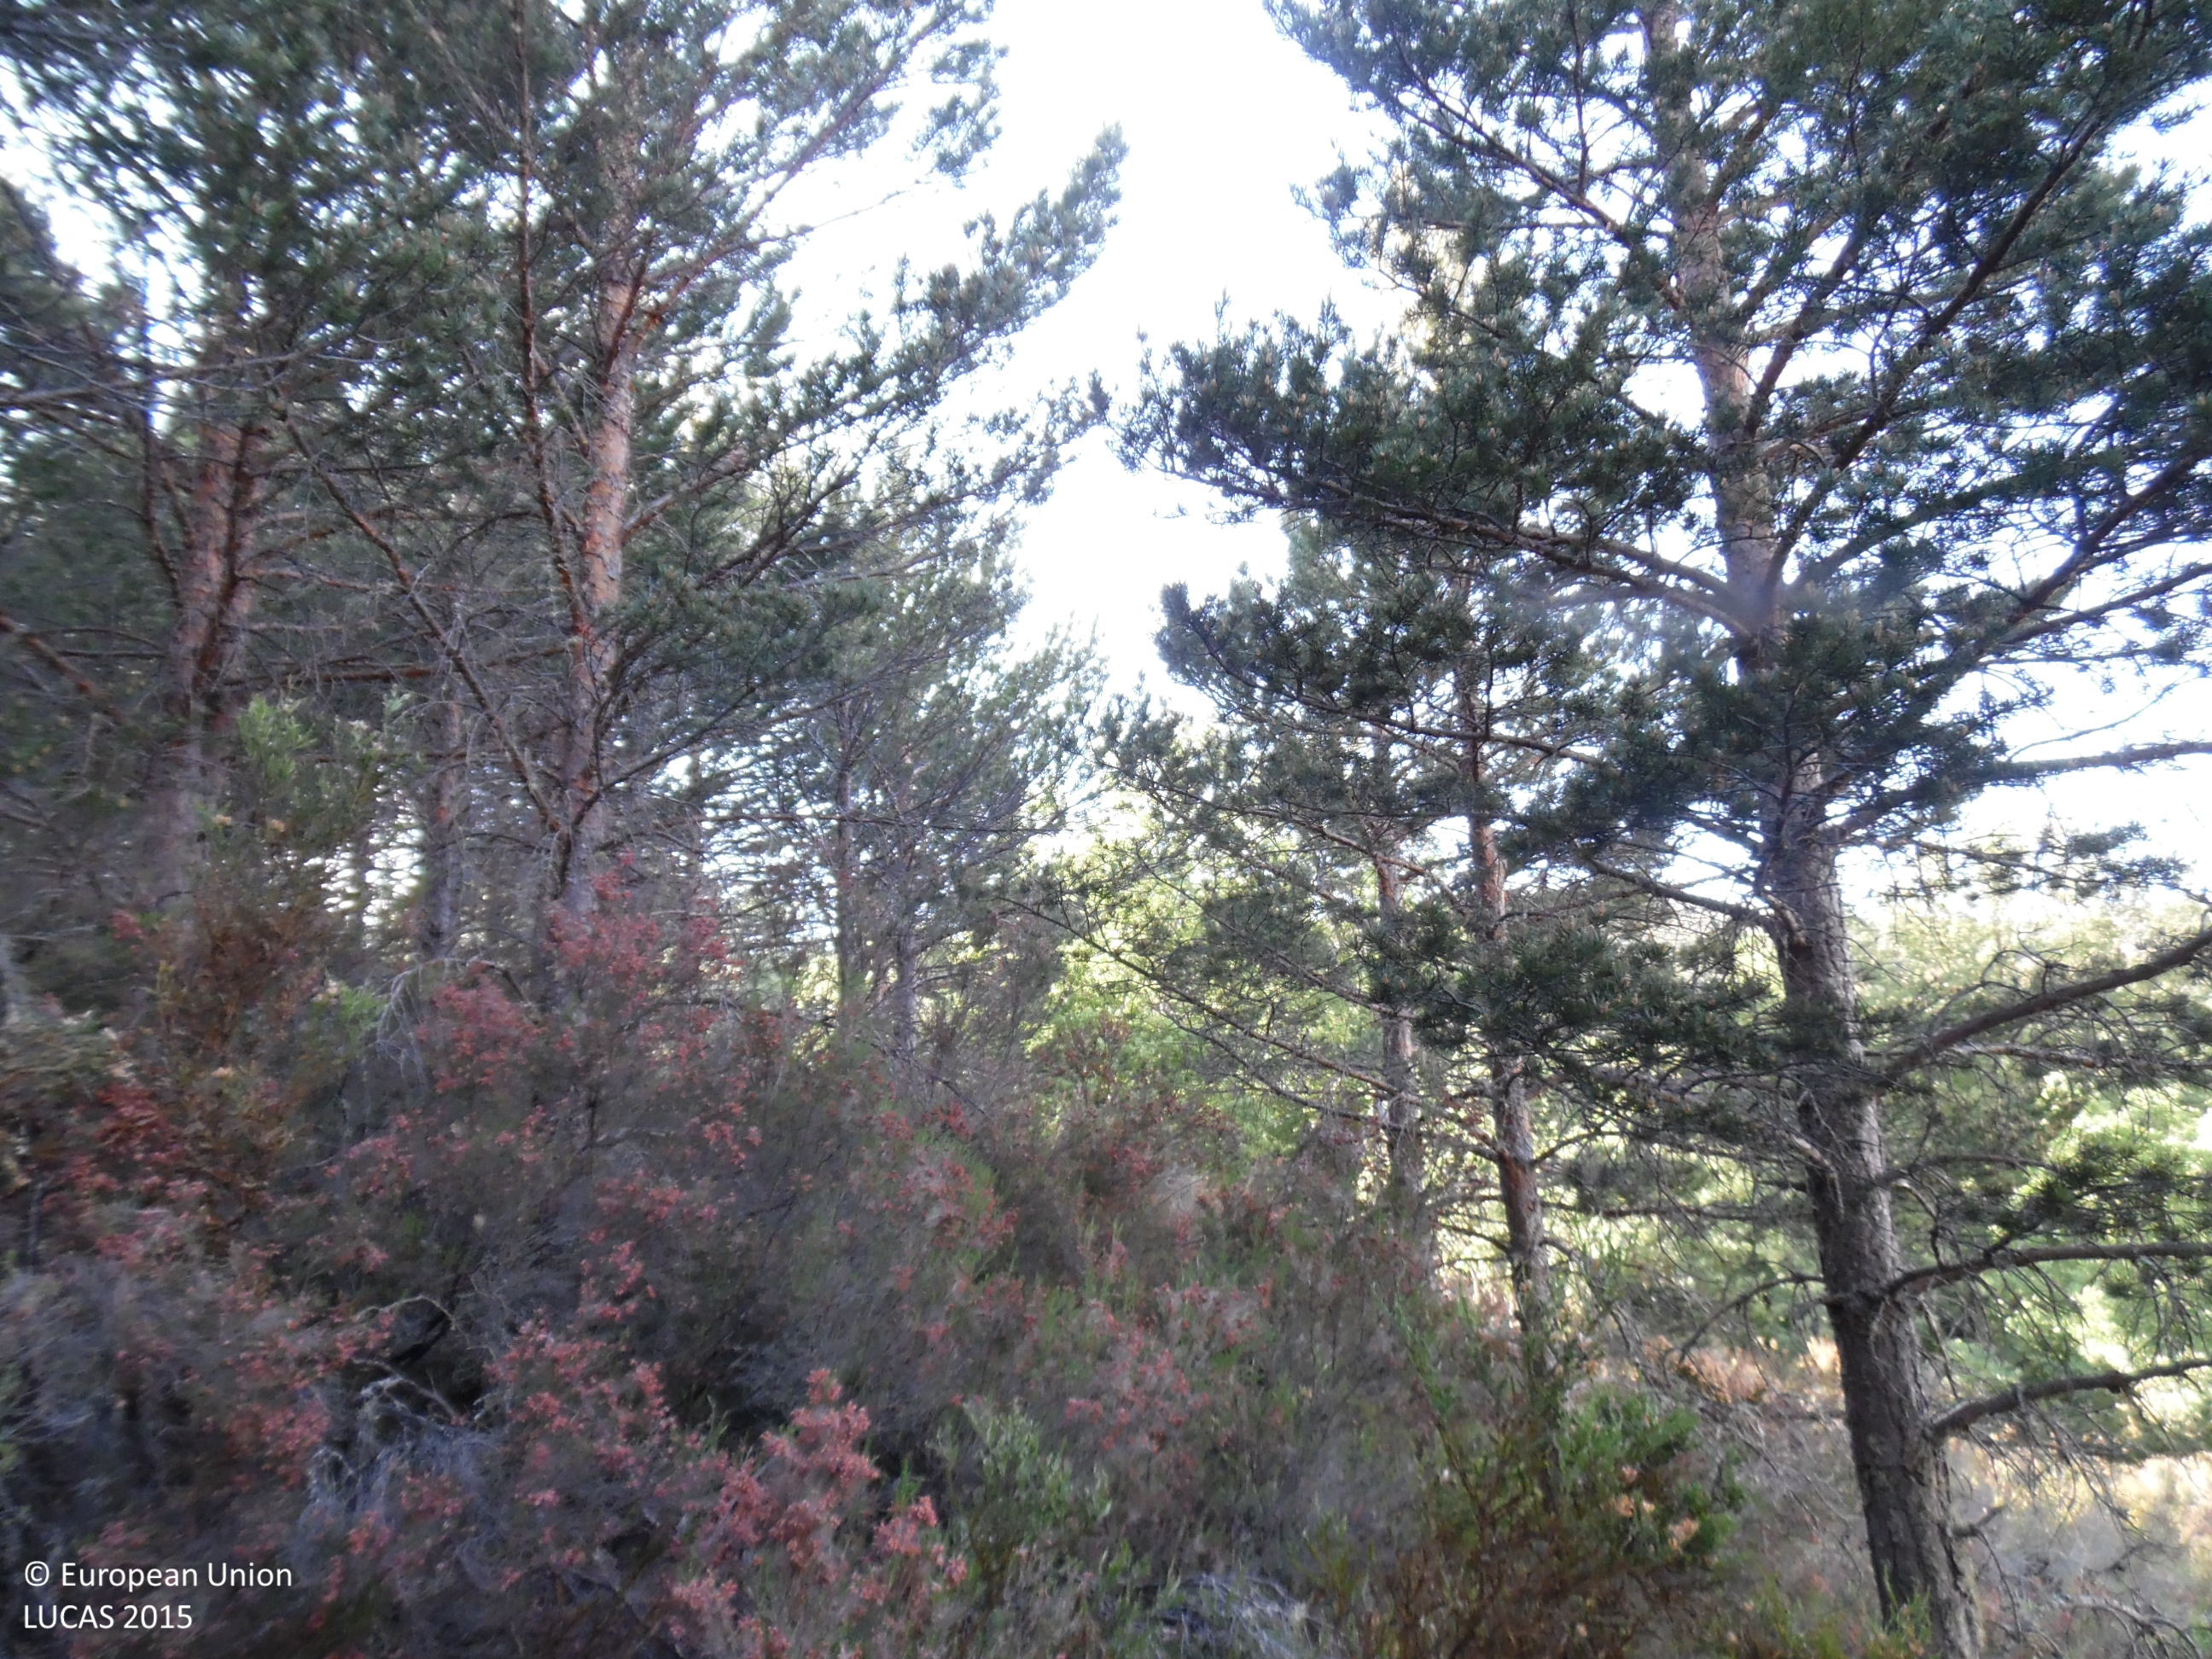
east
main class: Woodland
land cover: Pine dominated coniferous woodland
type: coniferous forest of the mediterranean region
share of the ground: > 75 %
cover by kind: coniferous forest trees 95 %, shrubs 5 %
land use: Forestry
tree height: > 5 m
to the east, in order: Pine dominated coniferous woodland; Shrubland with sparse tree cover; Rock outcrops; Shrubland with sparse tree cover; Shrubland without tree cover; Broadleaved woodland
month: May
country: ES
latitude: 42.1762
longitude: -6.3679
